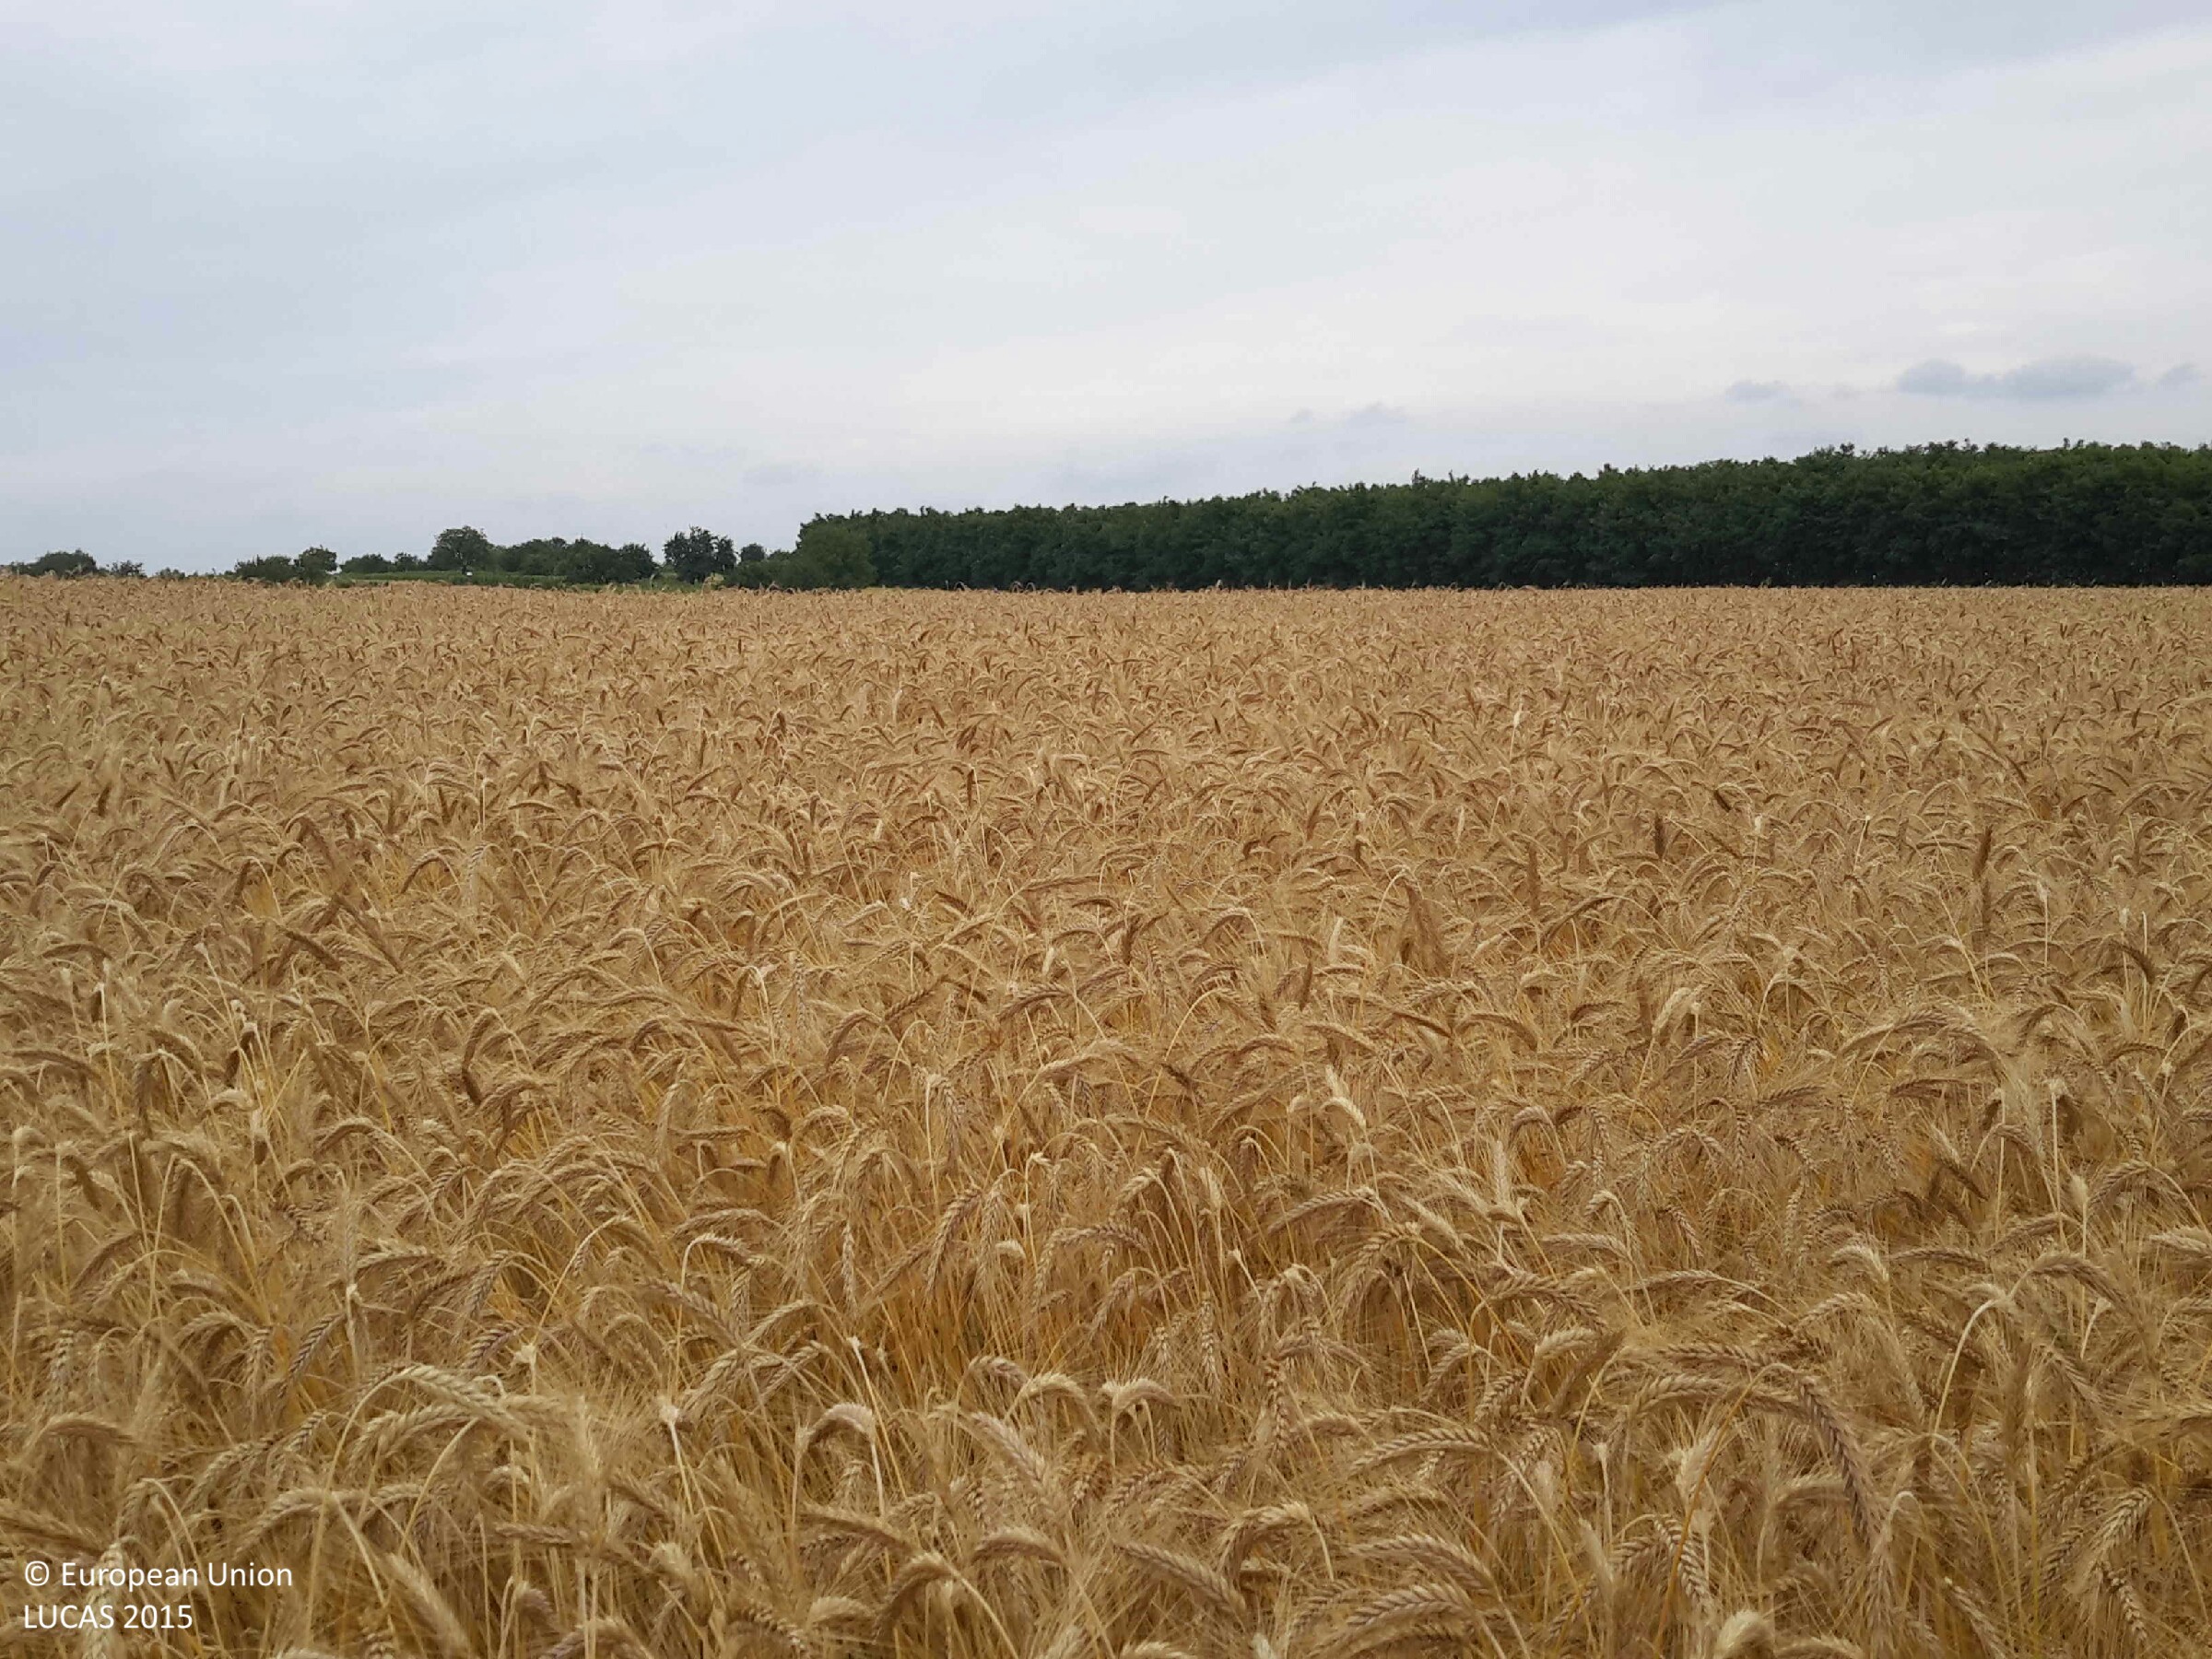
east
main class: Cropland
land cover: Common wheat
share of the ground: > 75 %
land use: Agriculture (excluding fallow land and kitchen gardens)
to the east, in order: Common wheat; Spontaneously vegetated surfaces; Tracks; Grass margins; Barley; Broadleaved woodland
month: June
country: HU
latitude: 47.2808
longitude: 17.5034
